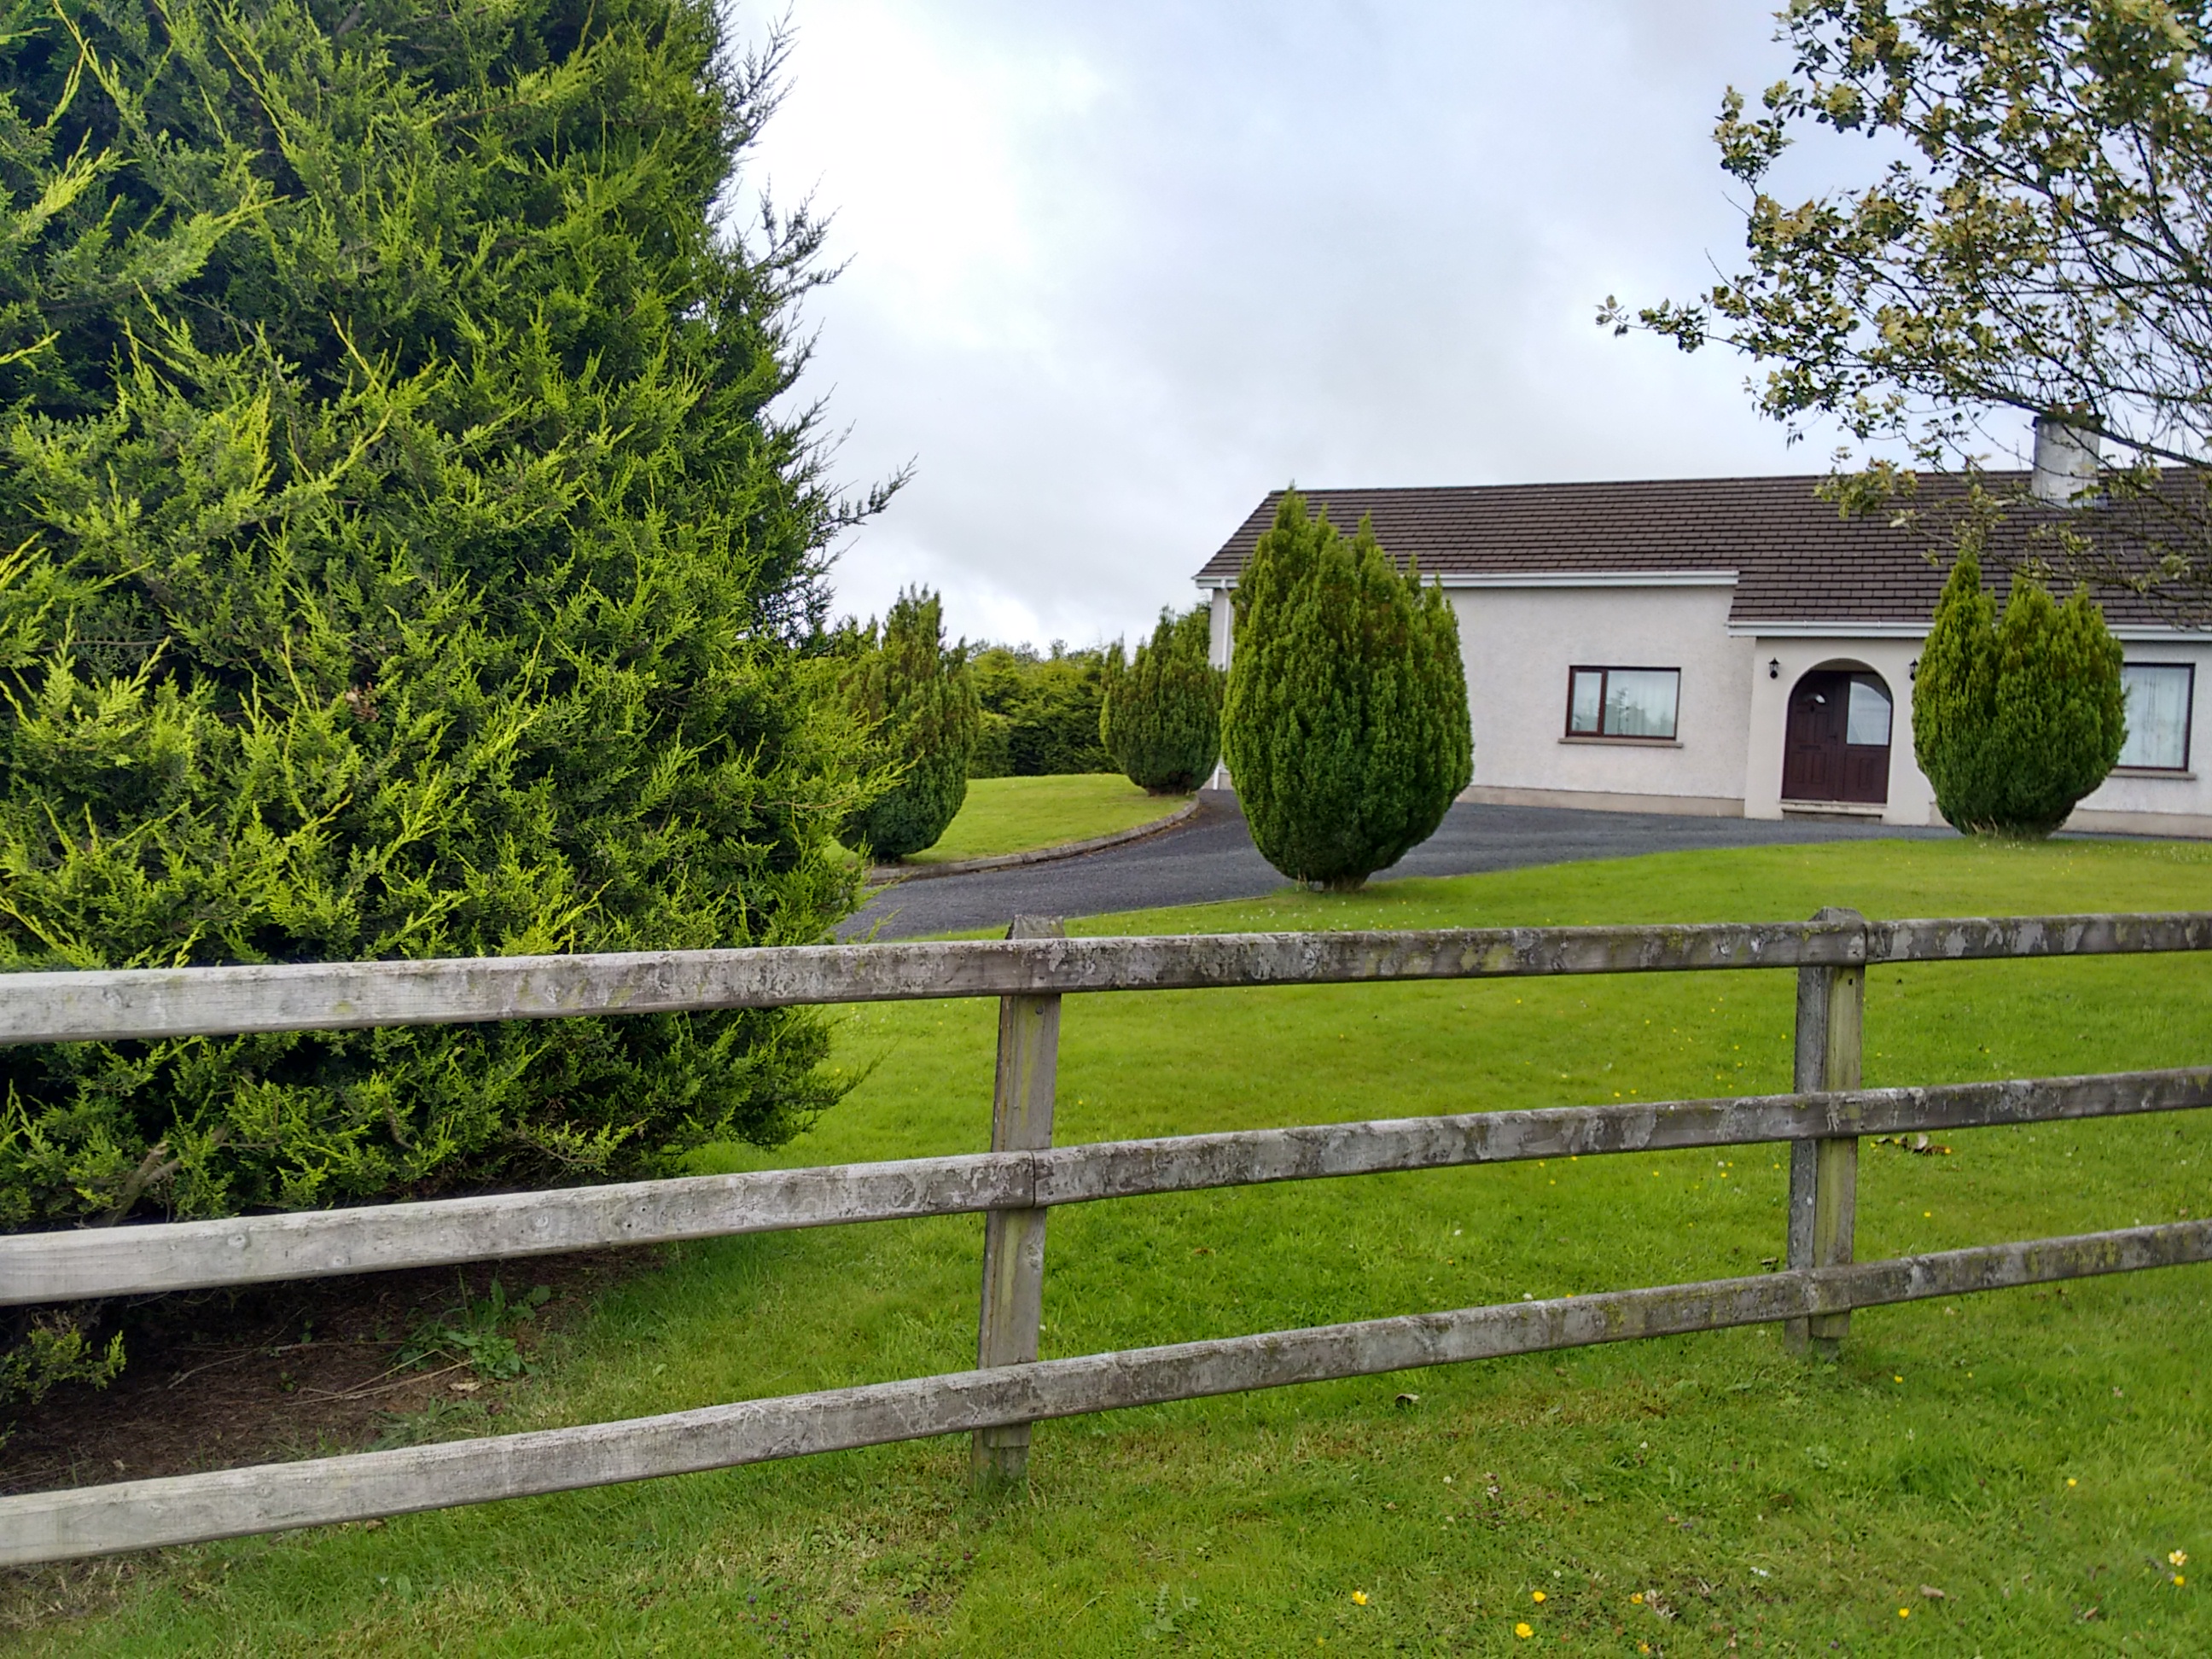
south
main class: Grassland
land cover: Grassland with sparse tree/shrub cover
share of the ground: > 75 %
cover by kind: herbaceous plants 85 %, shrubs 10 %, broadleaved forest trees 5 %
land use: Agriculture (excluding fallow land and kitchen gardens)
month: August
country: GB
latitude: 54.6330
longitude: -6.8821
